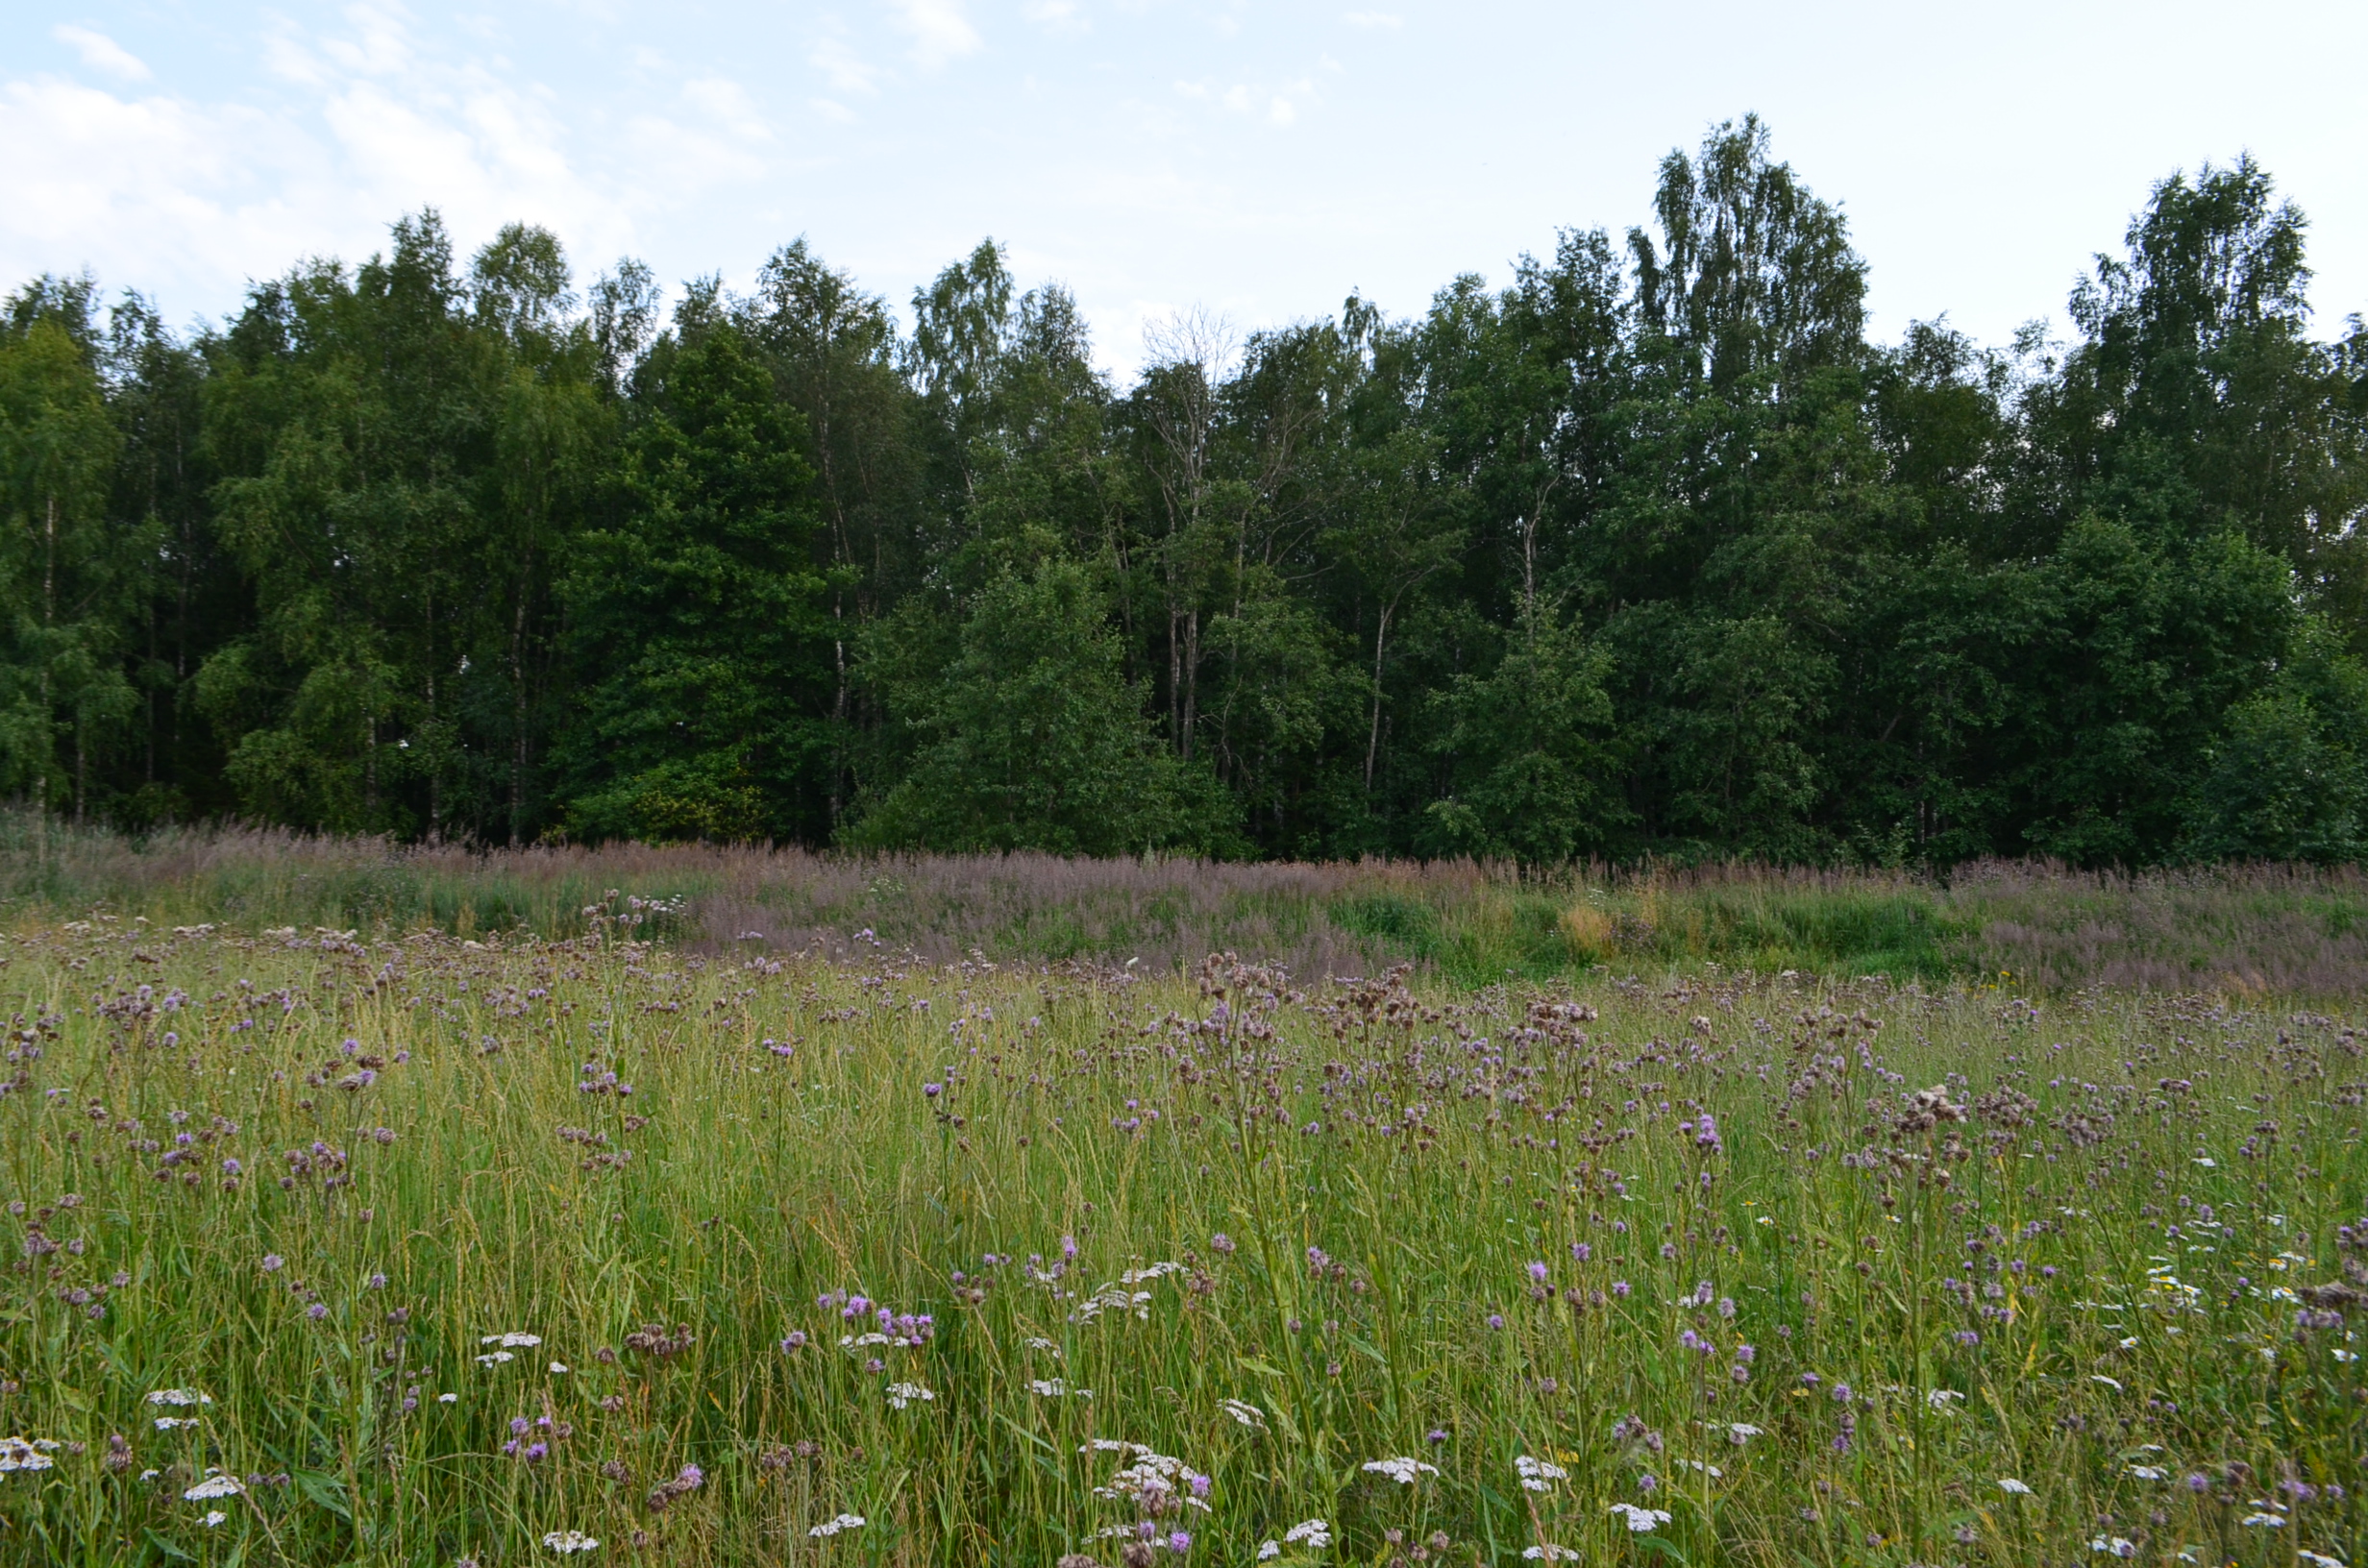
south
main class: Grassland
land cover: Spontaneously vegetated surfaces
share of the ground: > 75 %
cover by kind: herbaceous plants 100 %
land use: Semi-natural and natural areas not in use
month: August
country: LV
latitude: 57.2343
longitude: 21.8900
